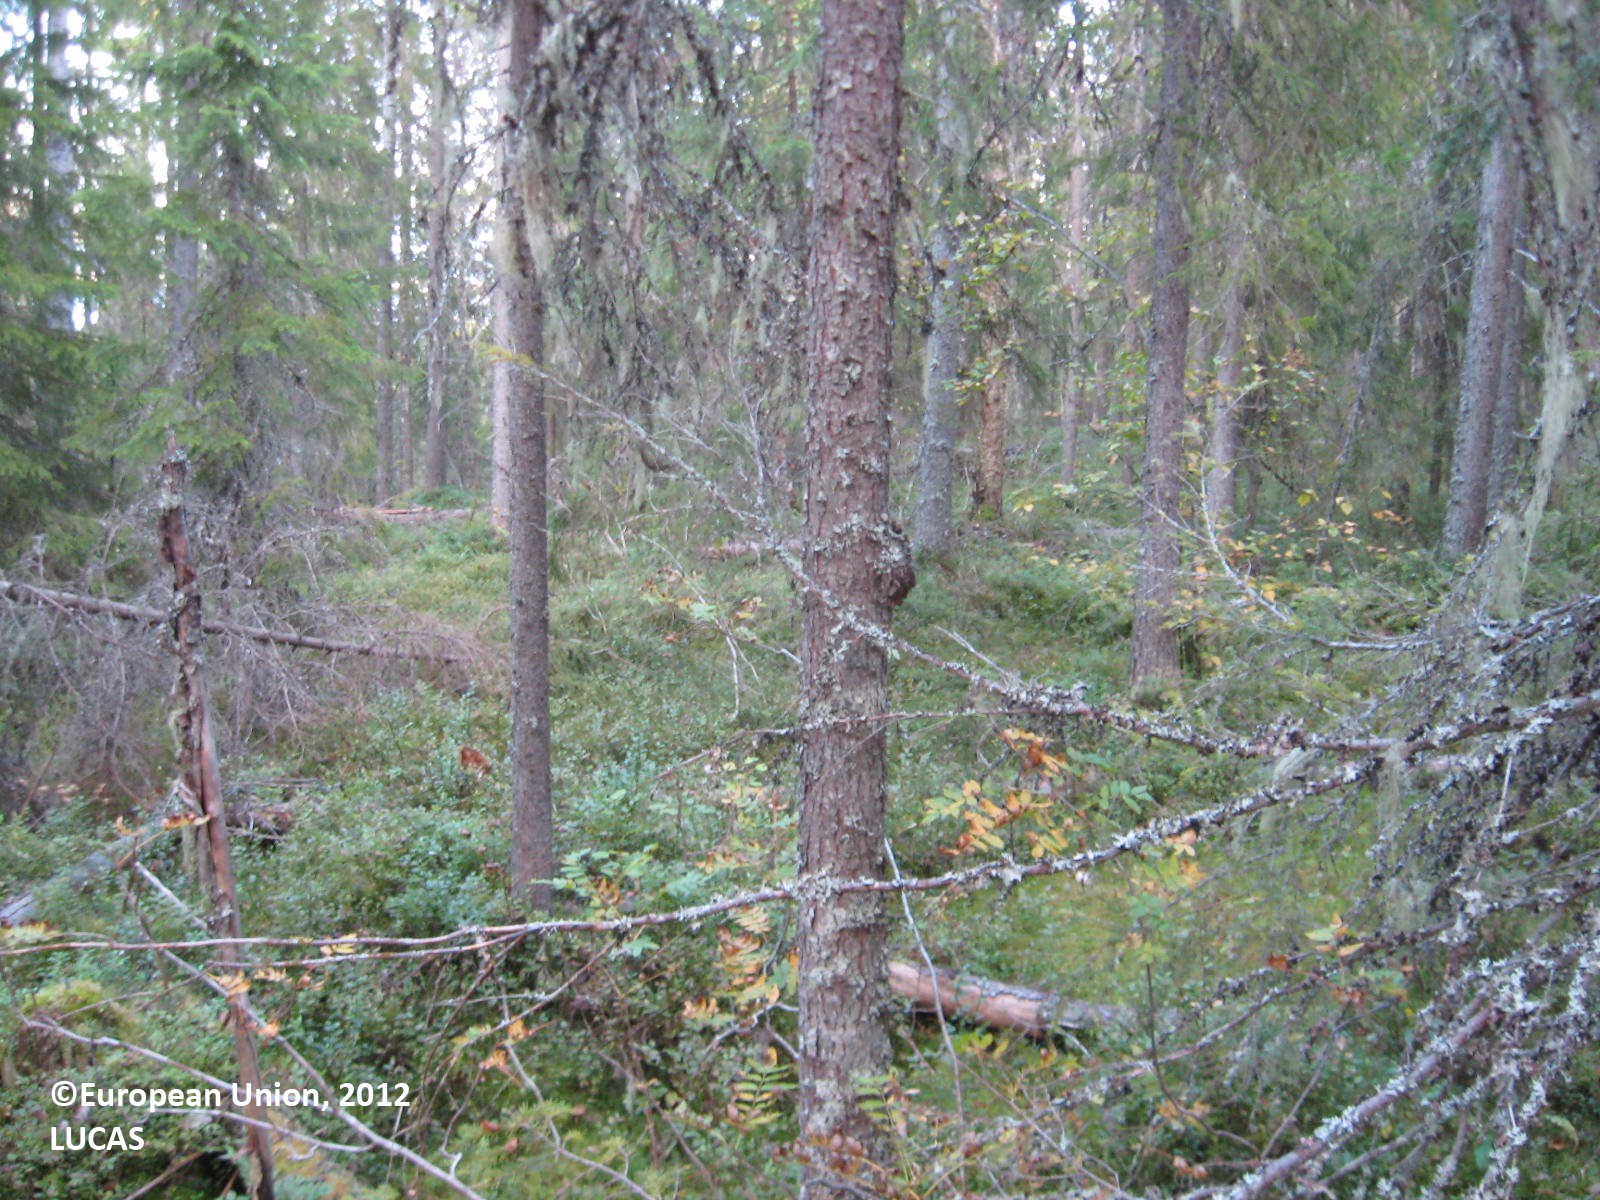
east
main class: Woodland
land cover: Other coniferous woodland
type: boreal forest
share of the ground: > 75 %
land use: Forestry
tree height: > 5 m
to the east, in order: Other coniferous woodland
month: August
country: FI
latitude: 63.8789
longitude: 29.7982
